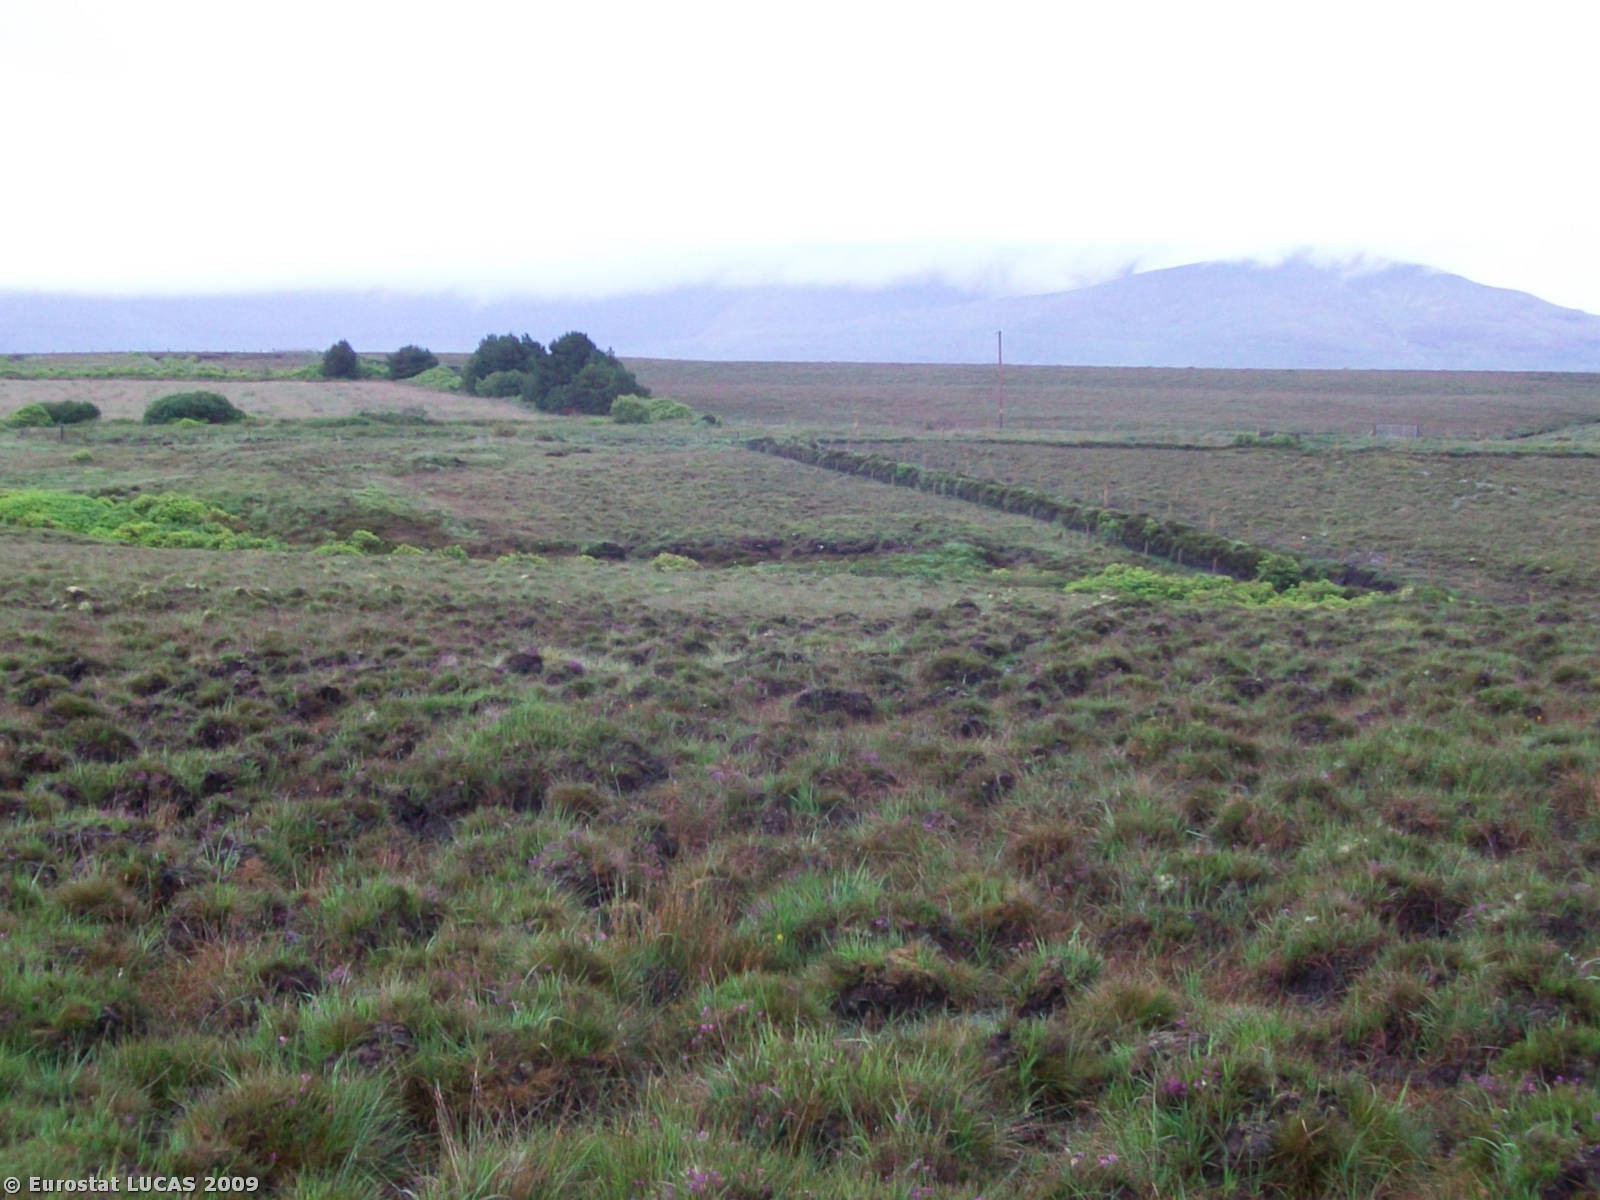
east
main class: Wetlands
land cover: Peatbogs
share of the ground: > 75 %
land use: Unused
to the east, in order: Peatbogs; Grassland without tree/shrub cover
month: July
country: IE
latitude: 54.0078
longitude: -9.7901
